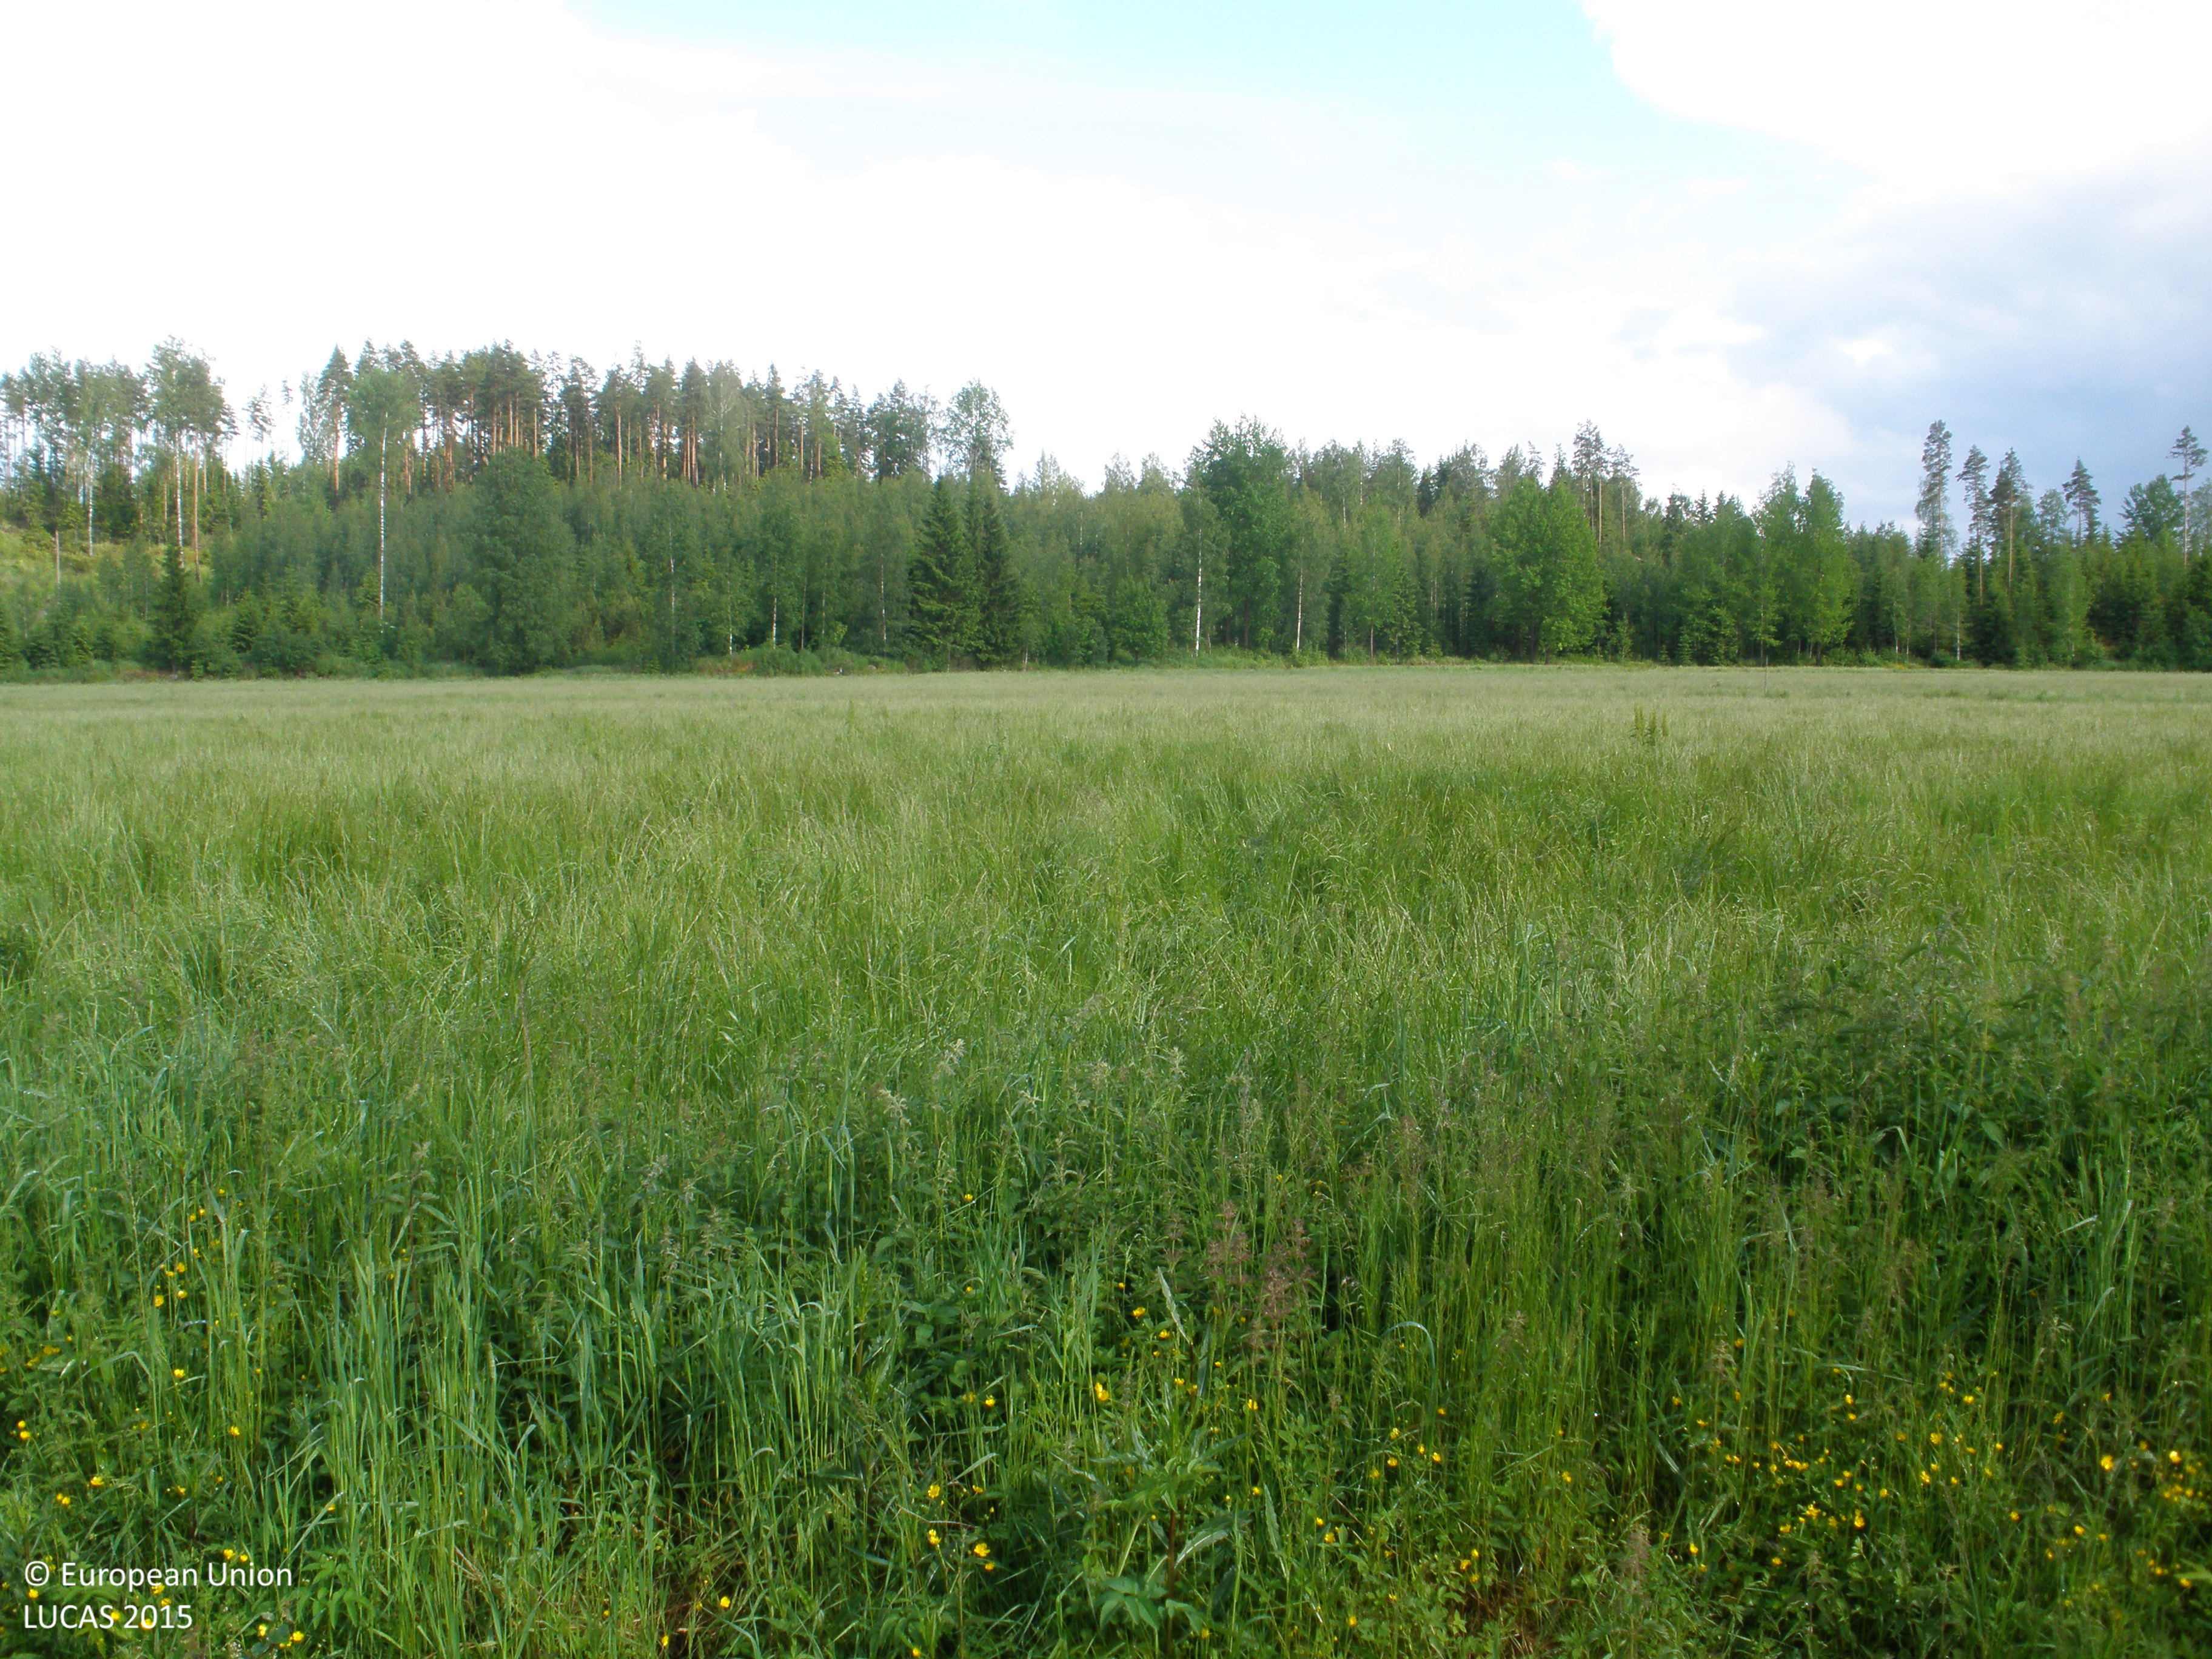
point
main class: Cropland
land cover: Temporary grasslands
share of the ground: > 75 %
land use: Agriculture (excluding fallow land and kitchen gardens)
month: June
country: FI
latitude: 60.9199
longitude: 23.4927
